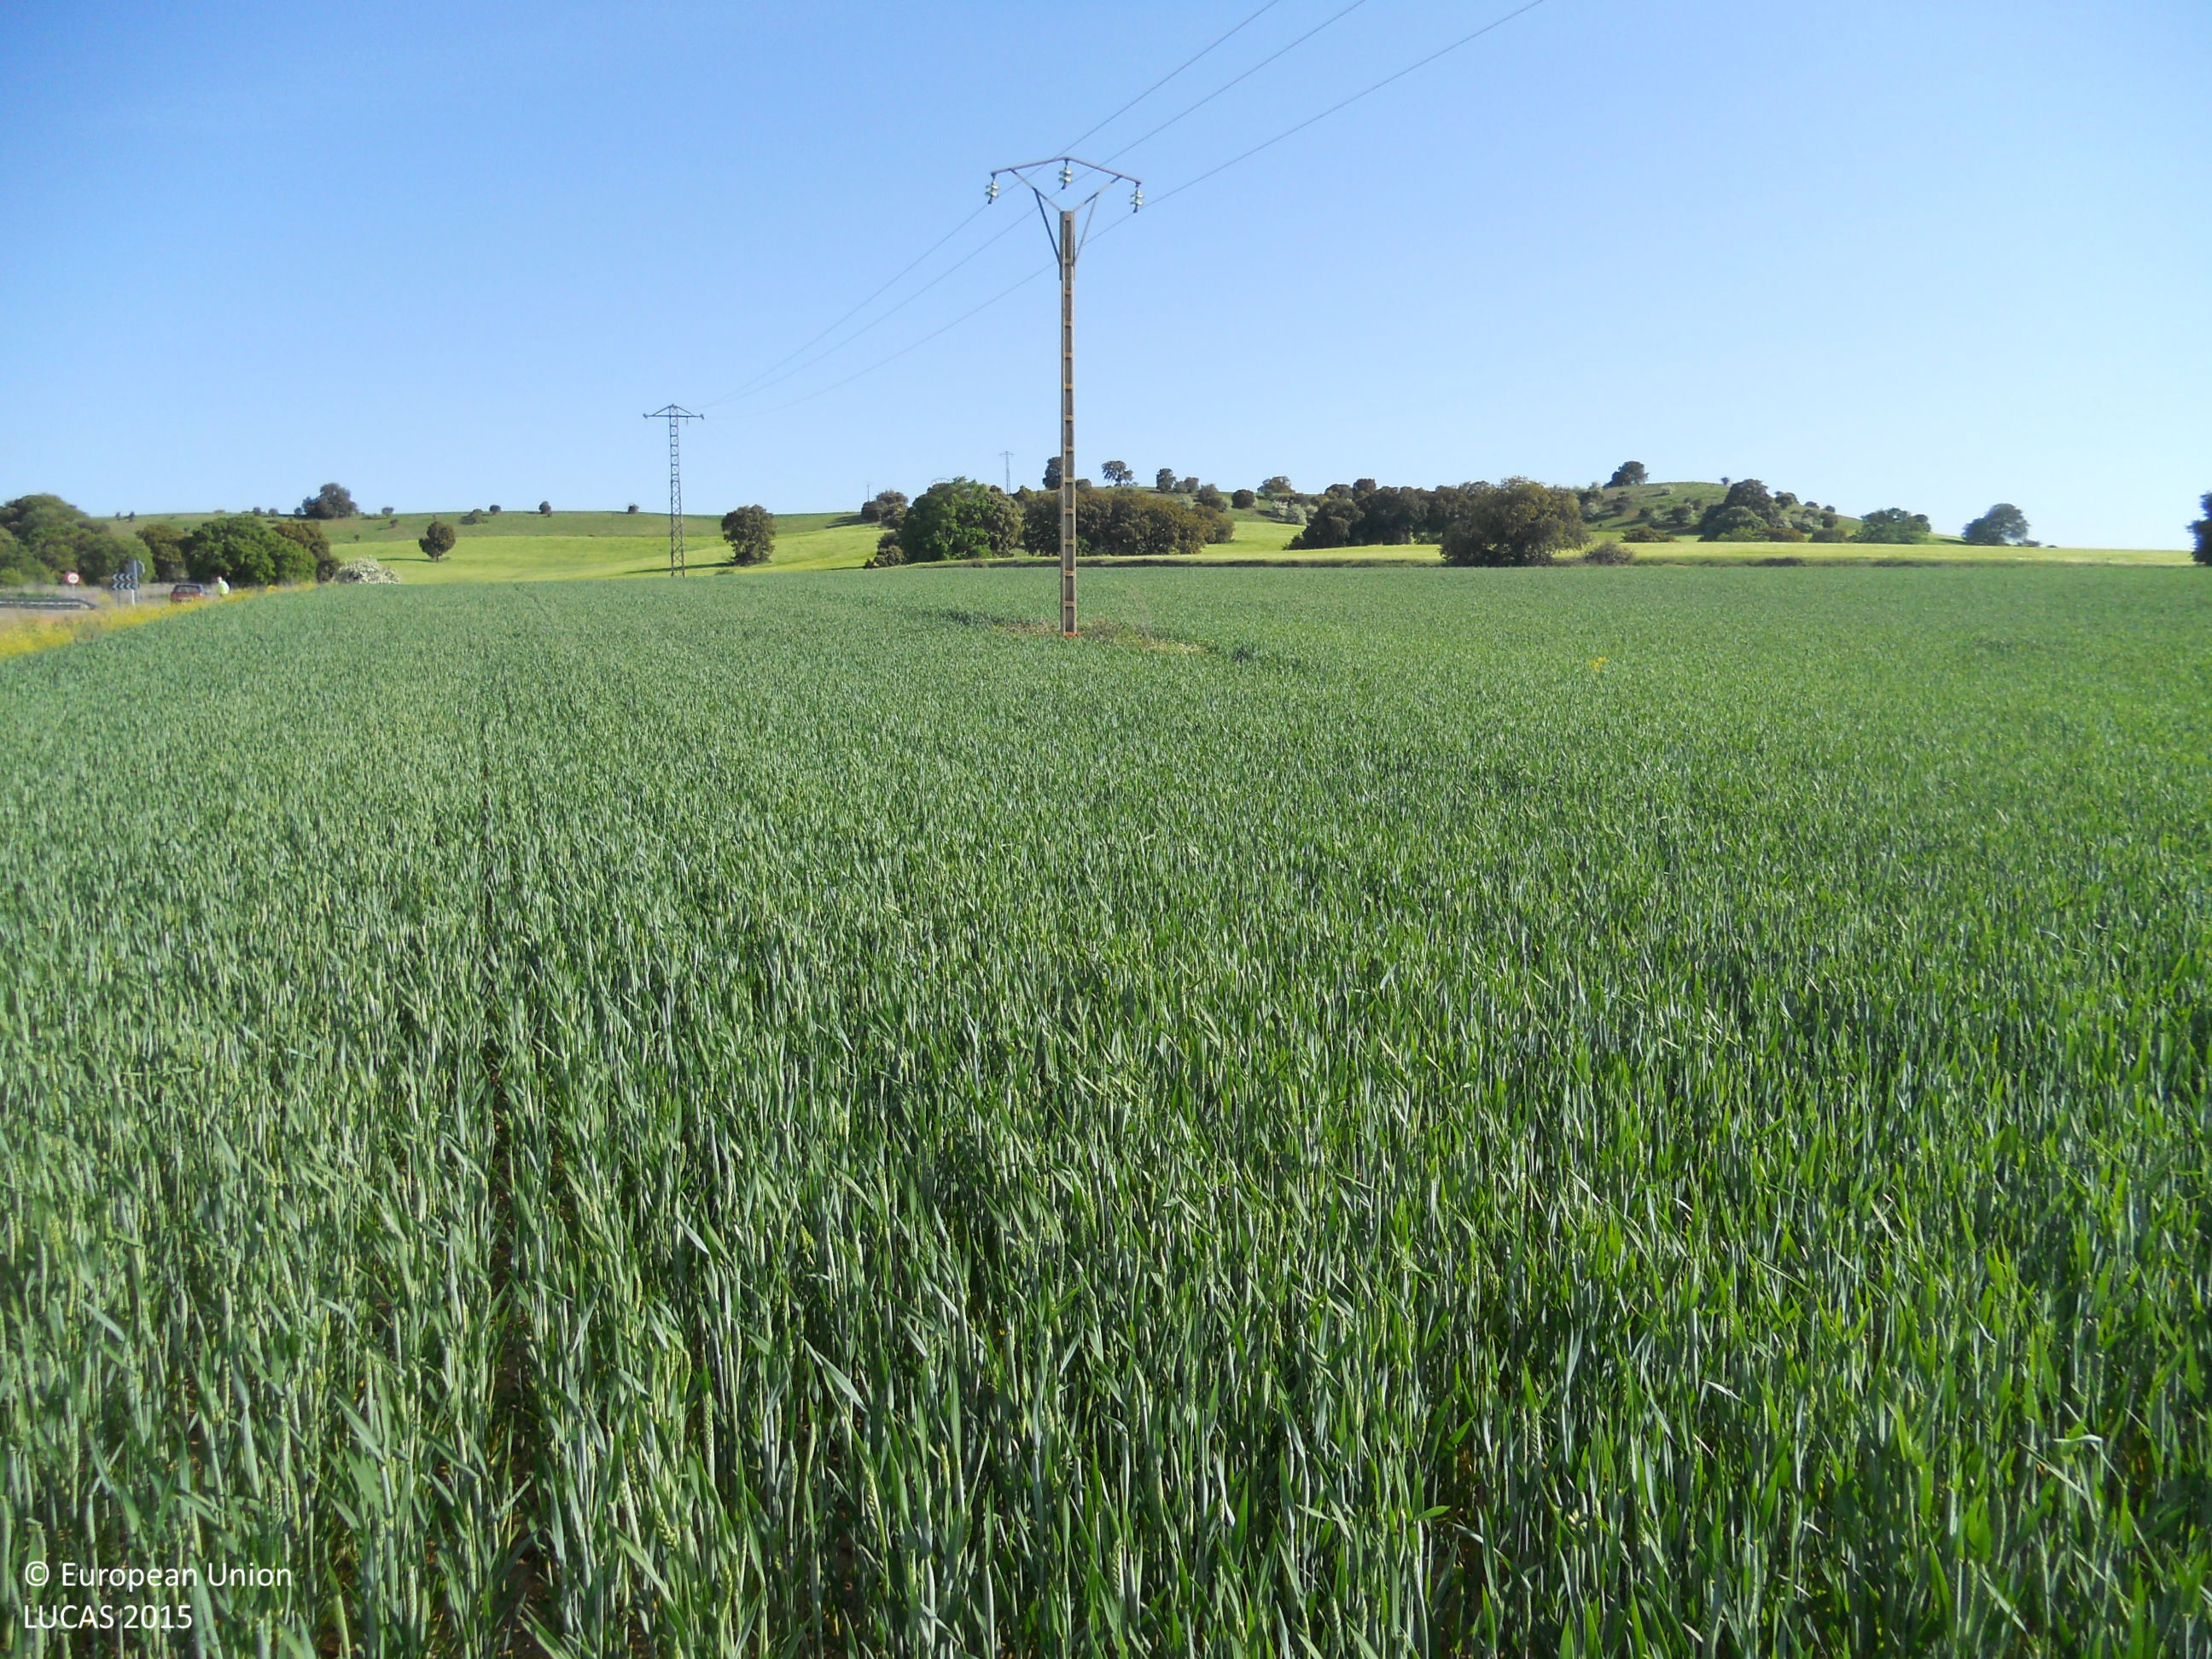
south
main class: Cropland
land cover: Common wheat
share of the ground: > 75 %
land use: Agriculture (excluding fallow land and kitchen gardens)
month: May
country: ES
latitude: 42.2426
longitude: -5.4943
